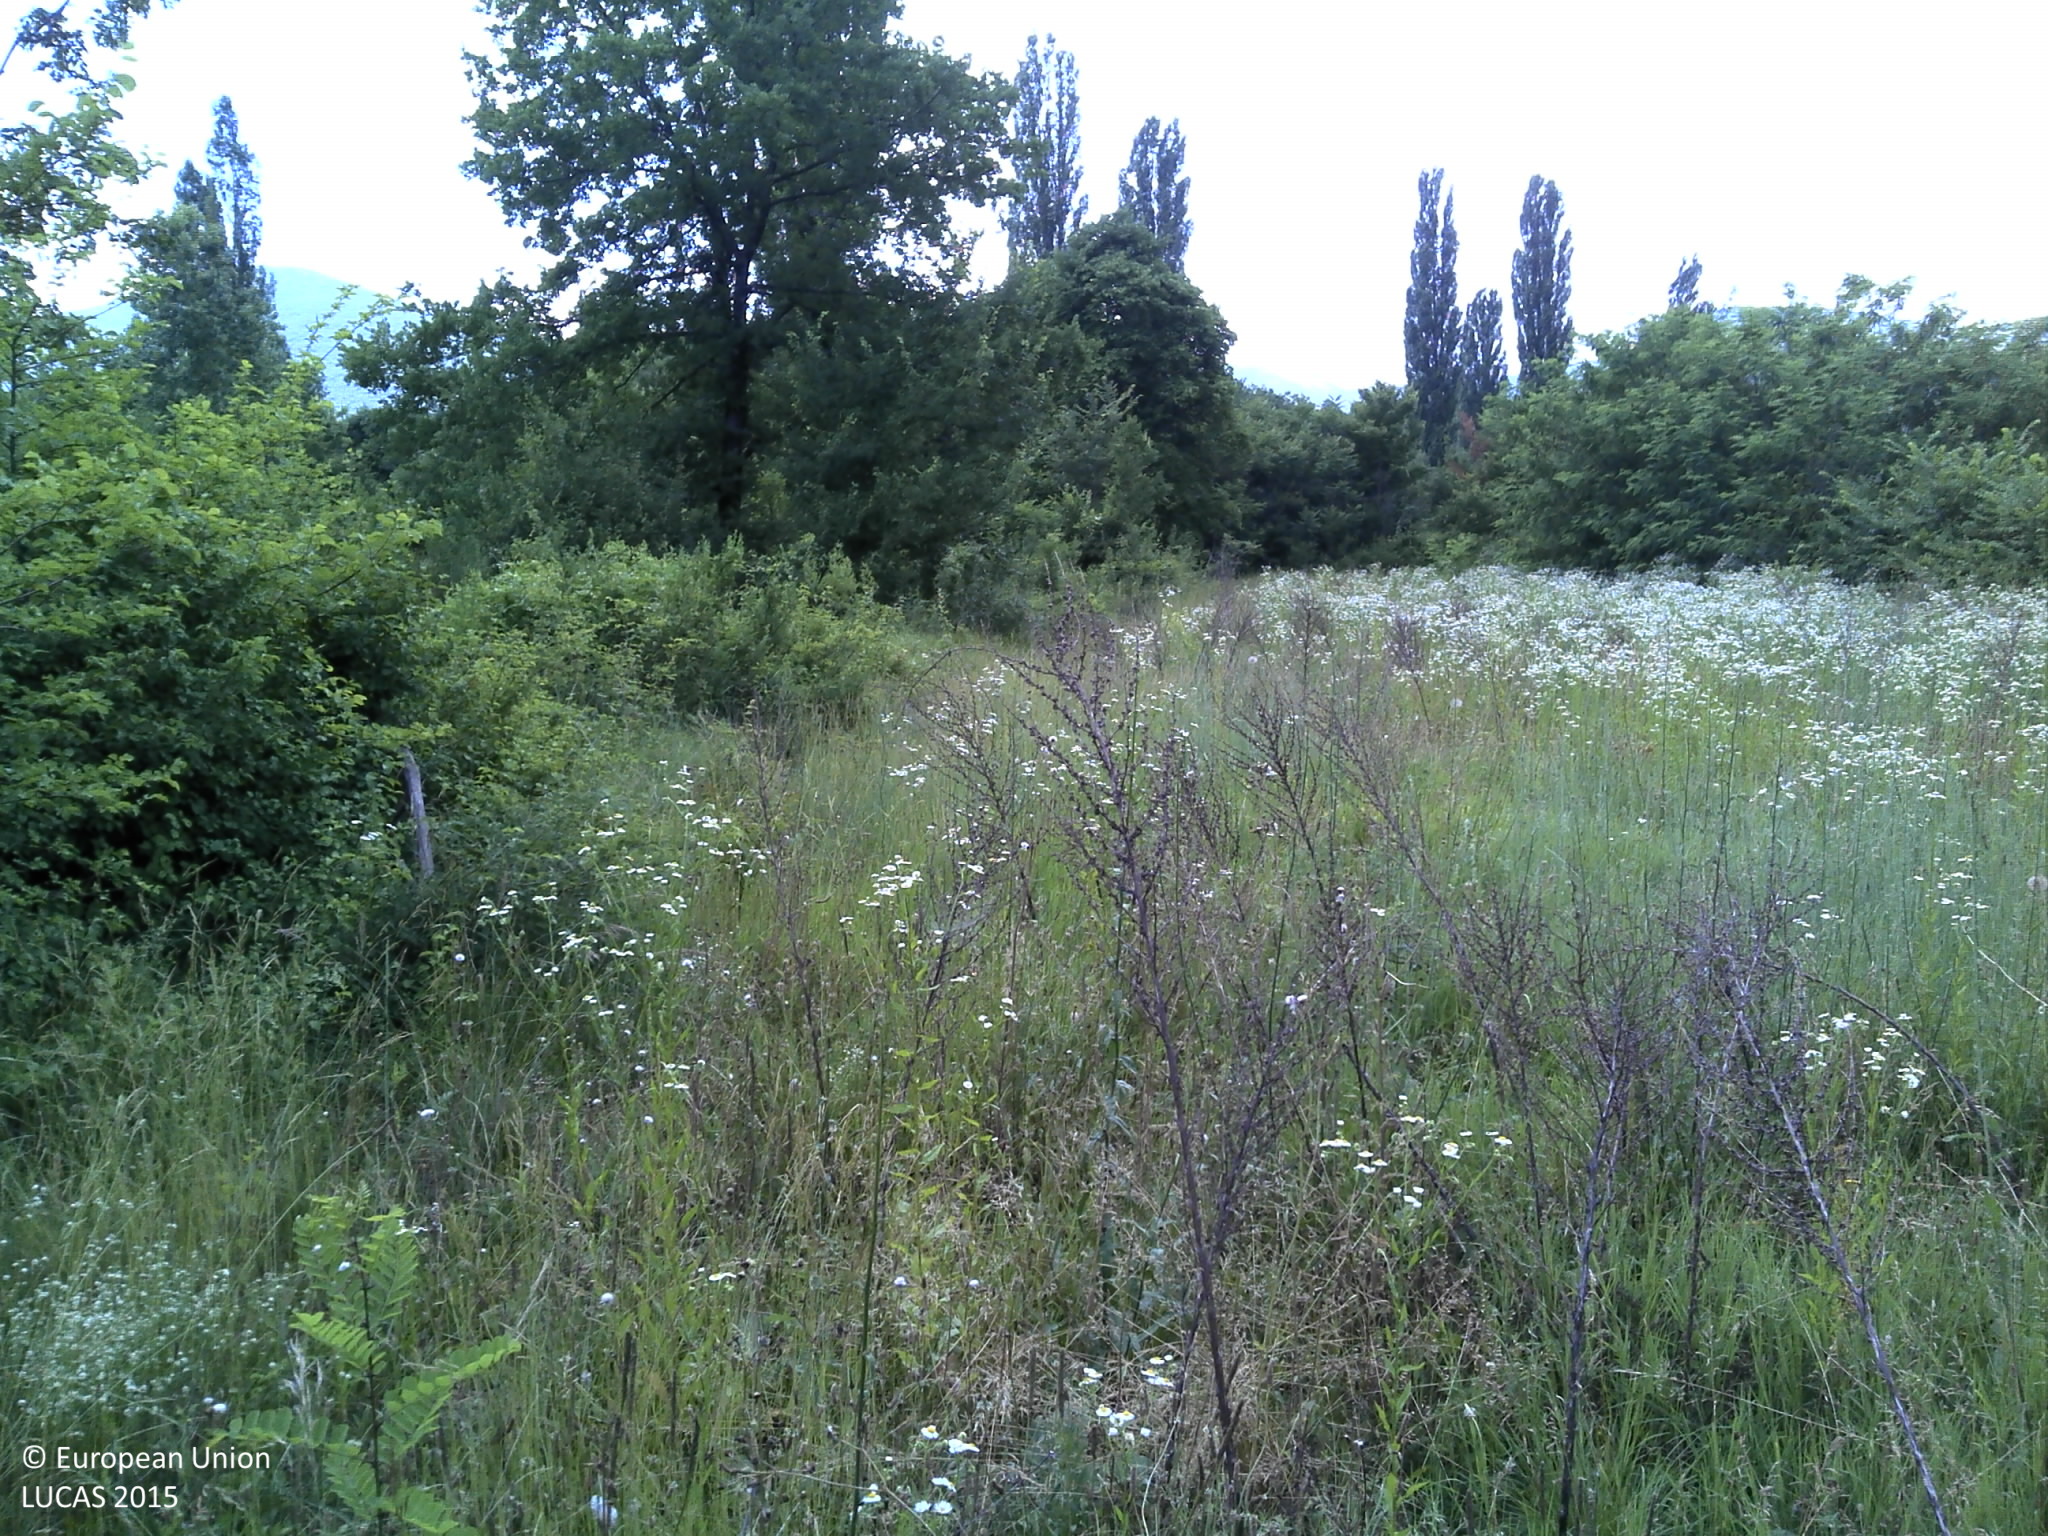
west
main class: Shrubland
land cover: Shrubland with sparse tree cover
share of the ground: 25 - 50 %
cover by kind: herbaceous plants 60 %, shrubs 35 %, broadleaved forest trees 5 %
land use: Semi-natural and natural areas not in use
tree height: > 5 m
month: June
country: HR
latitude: 43.7236
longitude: 16.6083
